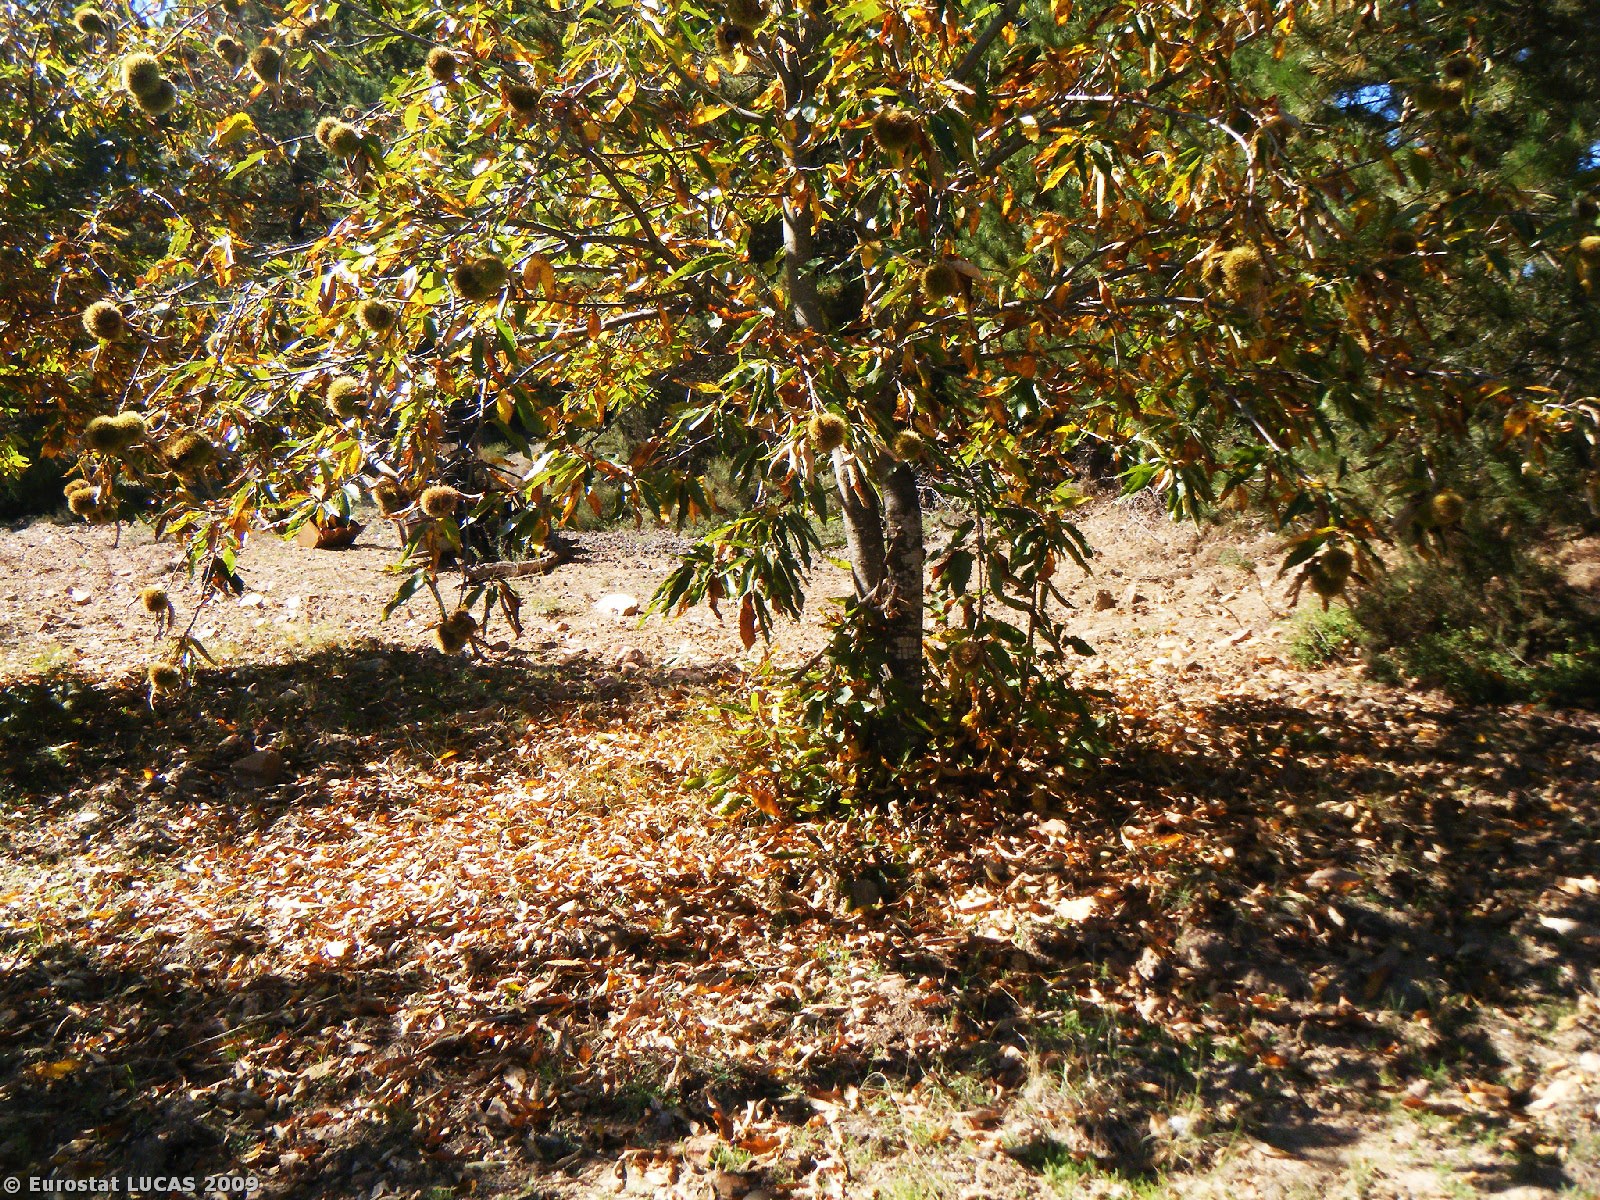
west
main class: Cropland
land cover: Nuts trees
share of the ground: 25 - 50 %
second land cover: Grassland with sparse tree/shrub cover
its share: > 75 %
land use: Agriculture (excluding fallow land and kitchen gardens)
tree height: > 5 m
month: October
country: GR
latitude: 37.3405
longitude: 22.3644
